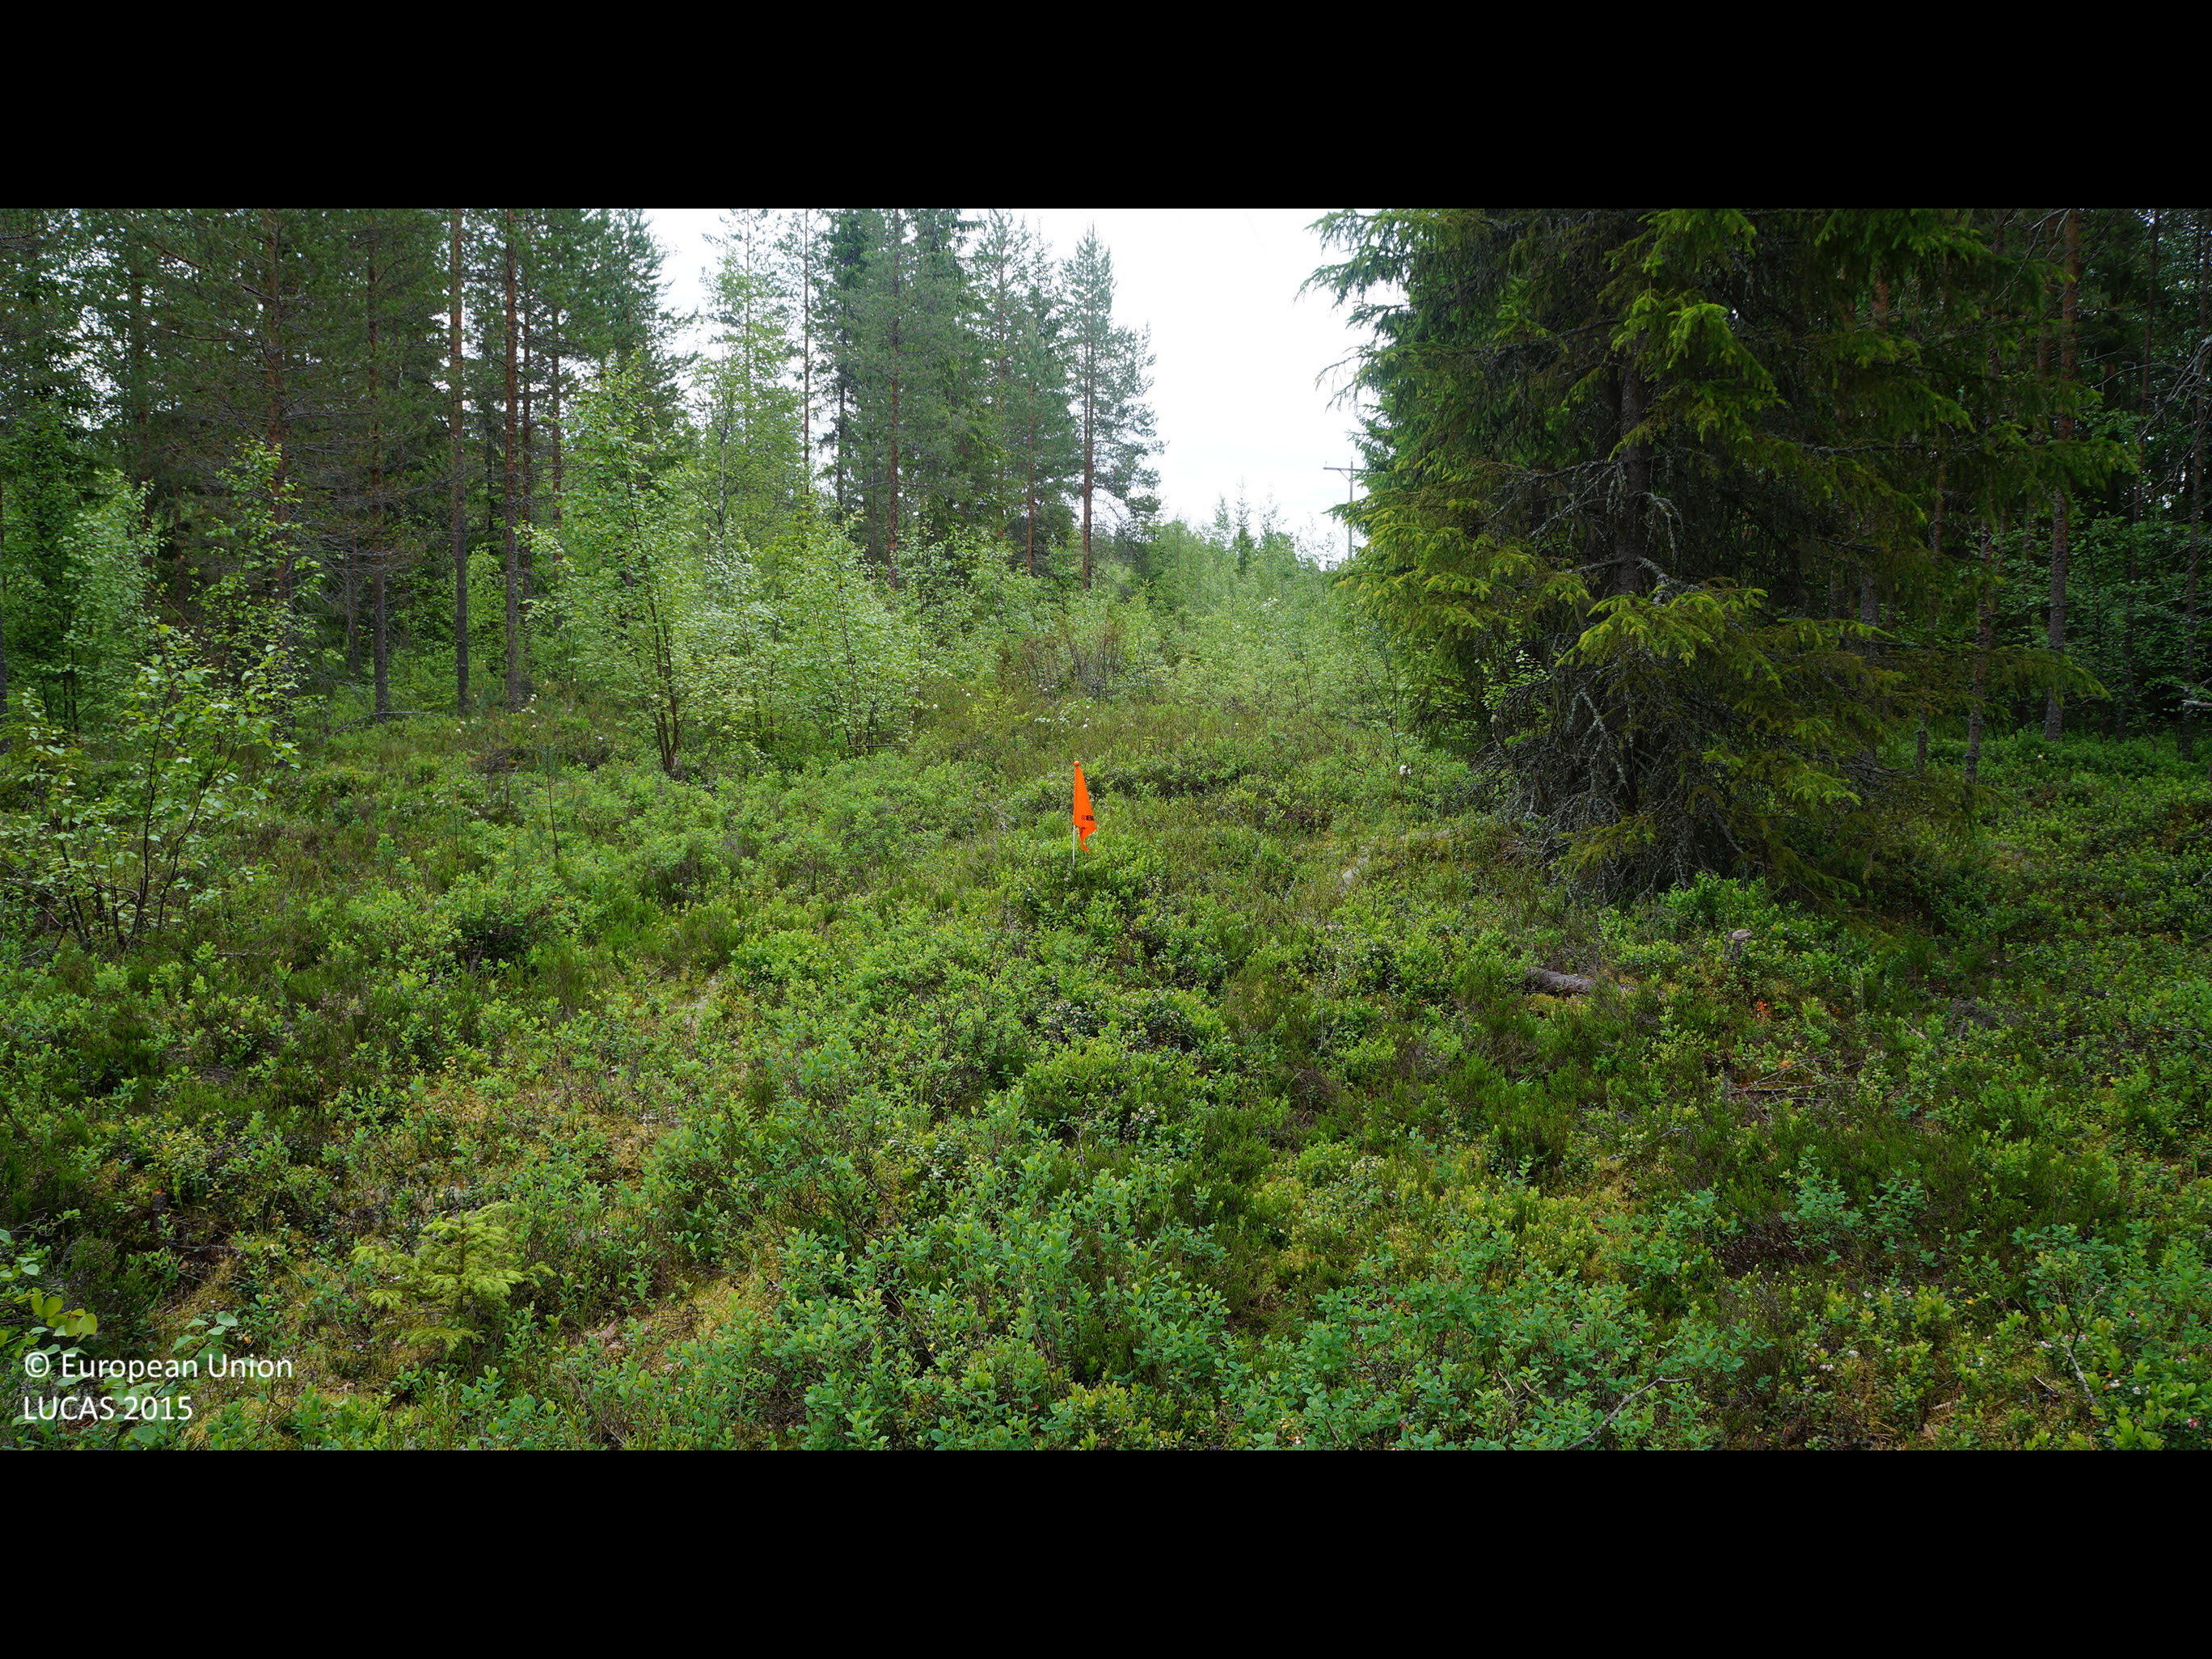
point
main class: Shrubland
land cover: Shrubland with sparse tree cover
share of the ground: > 75 %
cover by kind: shrubs 90 %, broadleaved forest trees 5 %, lichens and mosses 5 %
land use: Electricity, gas and thermal power distribution
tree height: < 5 m
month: July
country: FI
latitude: 64.2907
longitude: 24.3872
